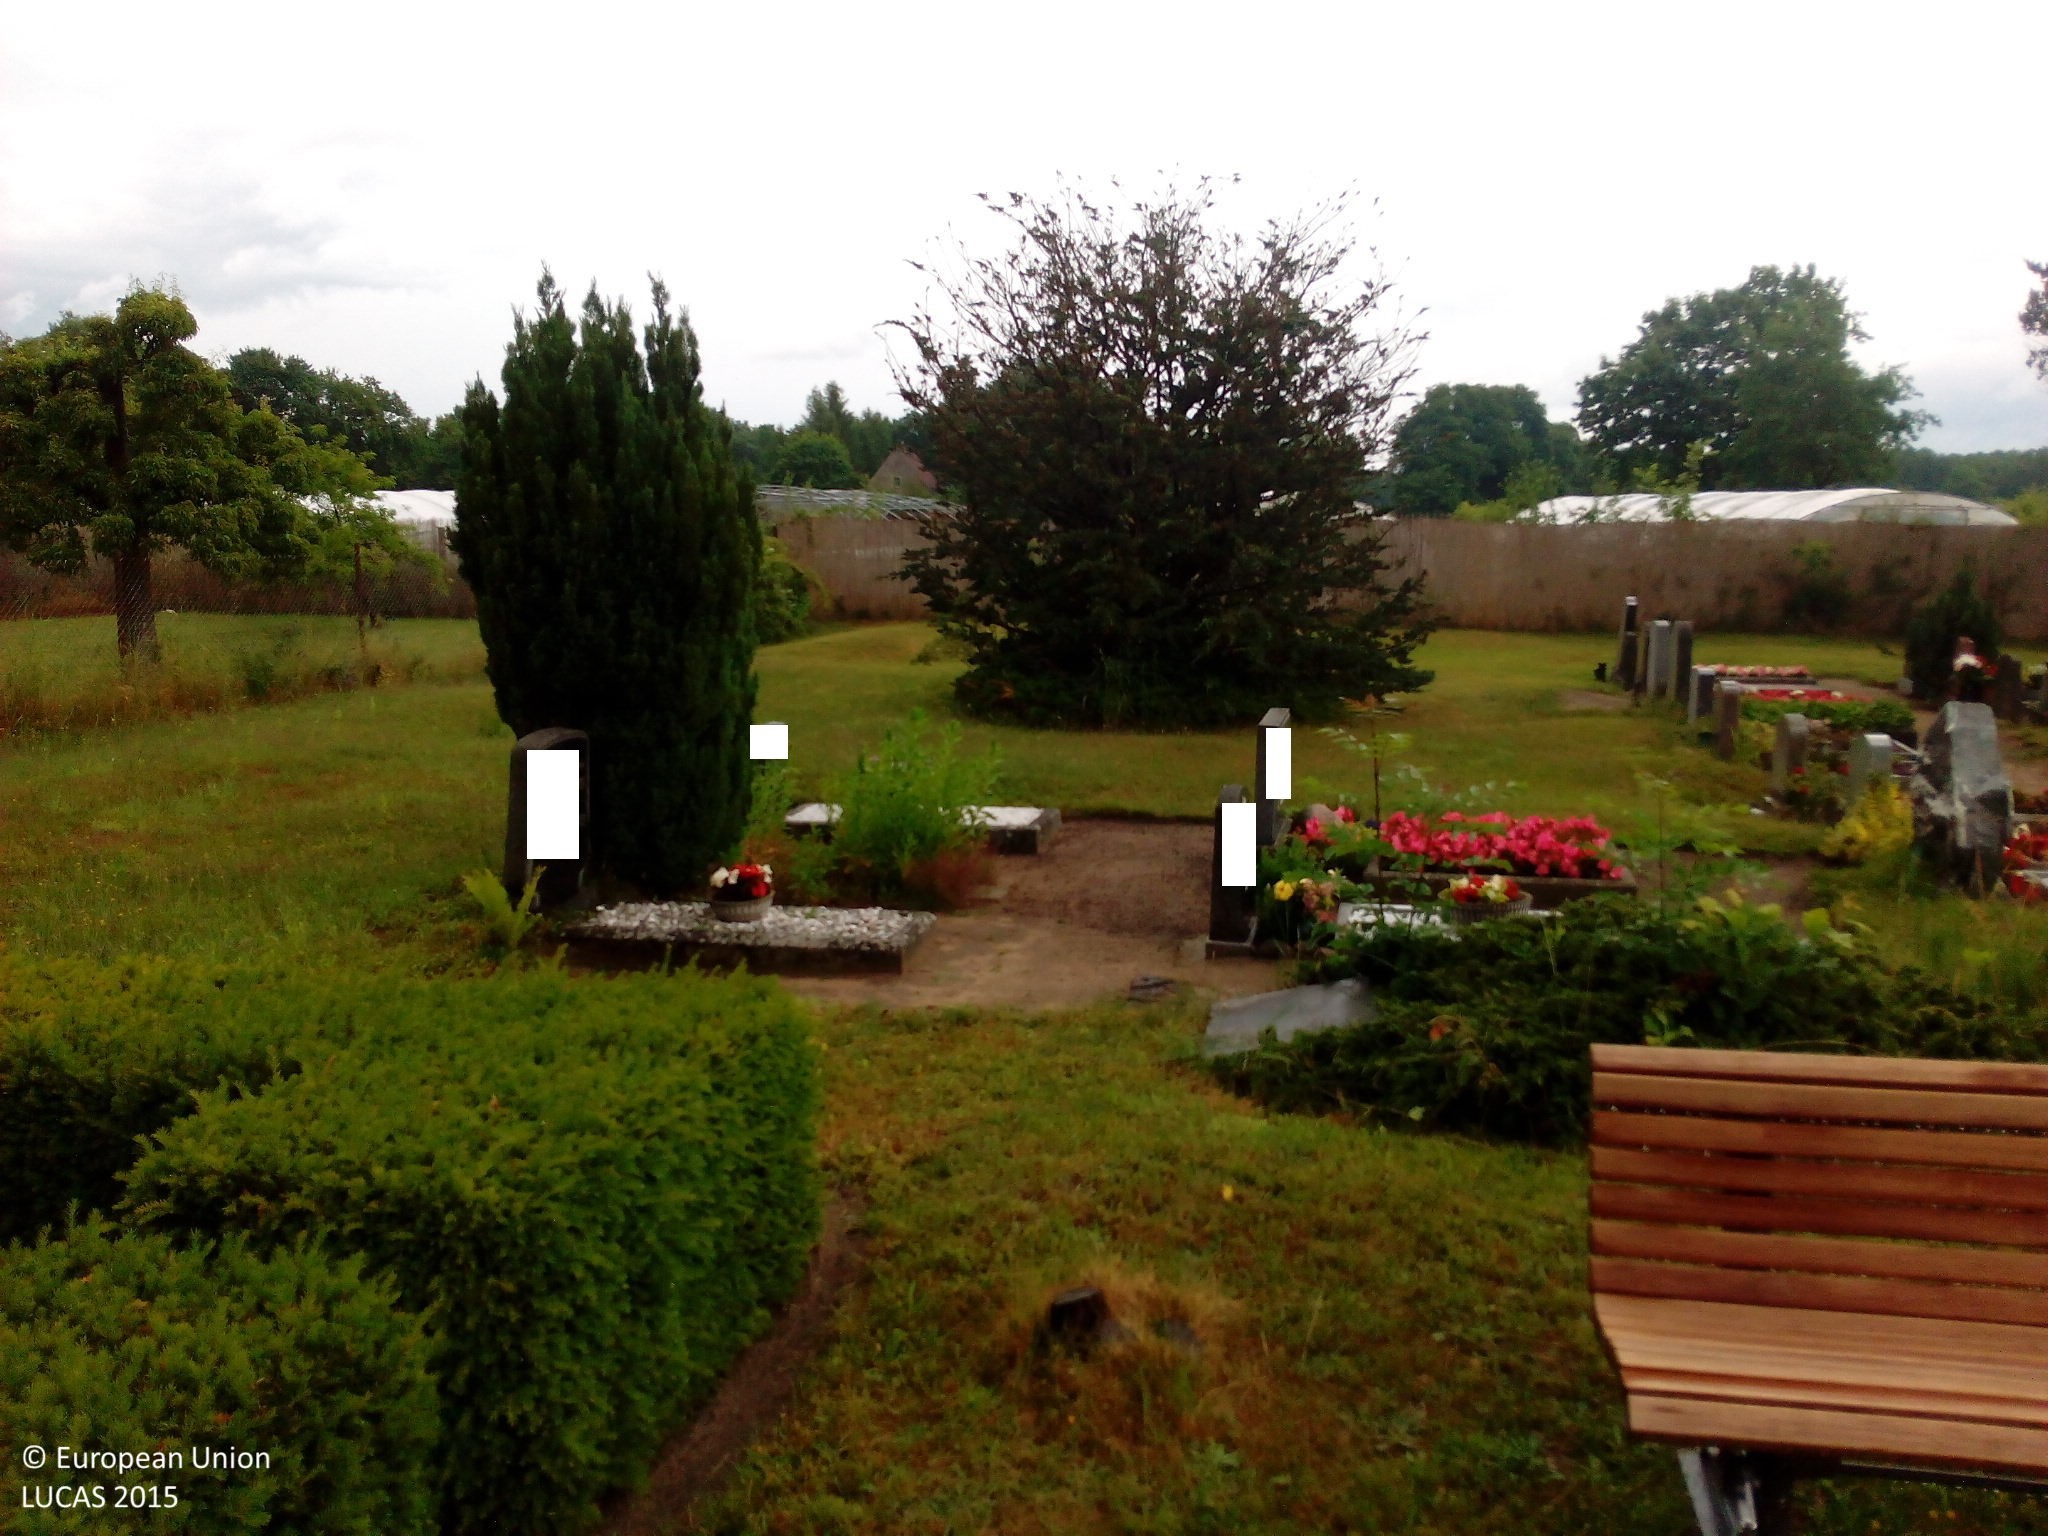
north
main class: Grassland
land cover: Grassland without tree/shrub cover
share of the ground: > 75 %
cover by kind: herbaceous plants 100 %
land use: Community services
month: June
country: DE
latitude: 52.4426
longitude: 12.4270
